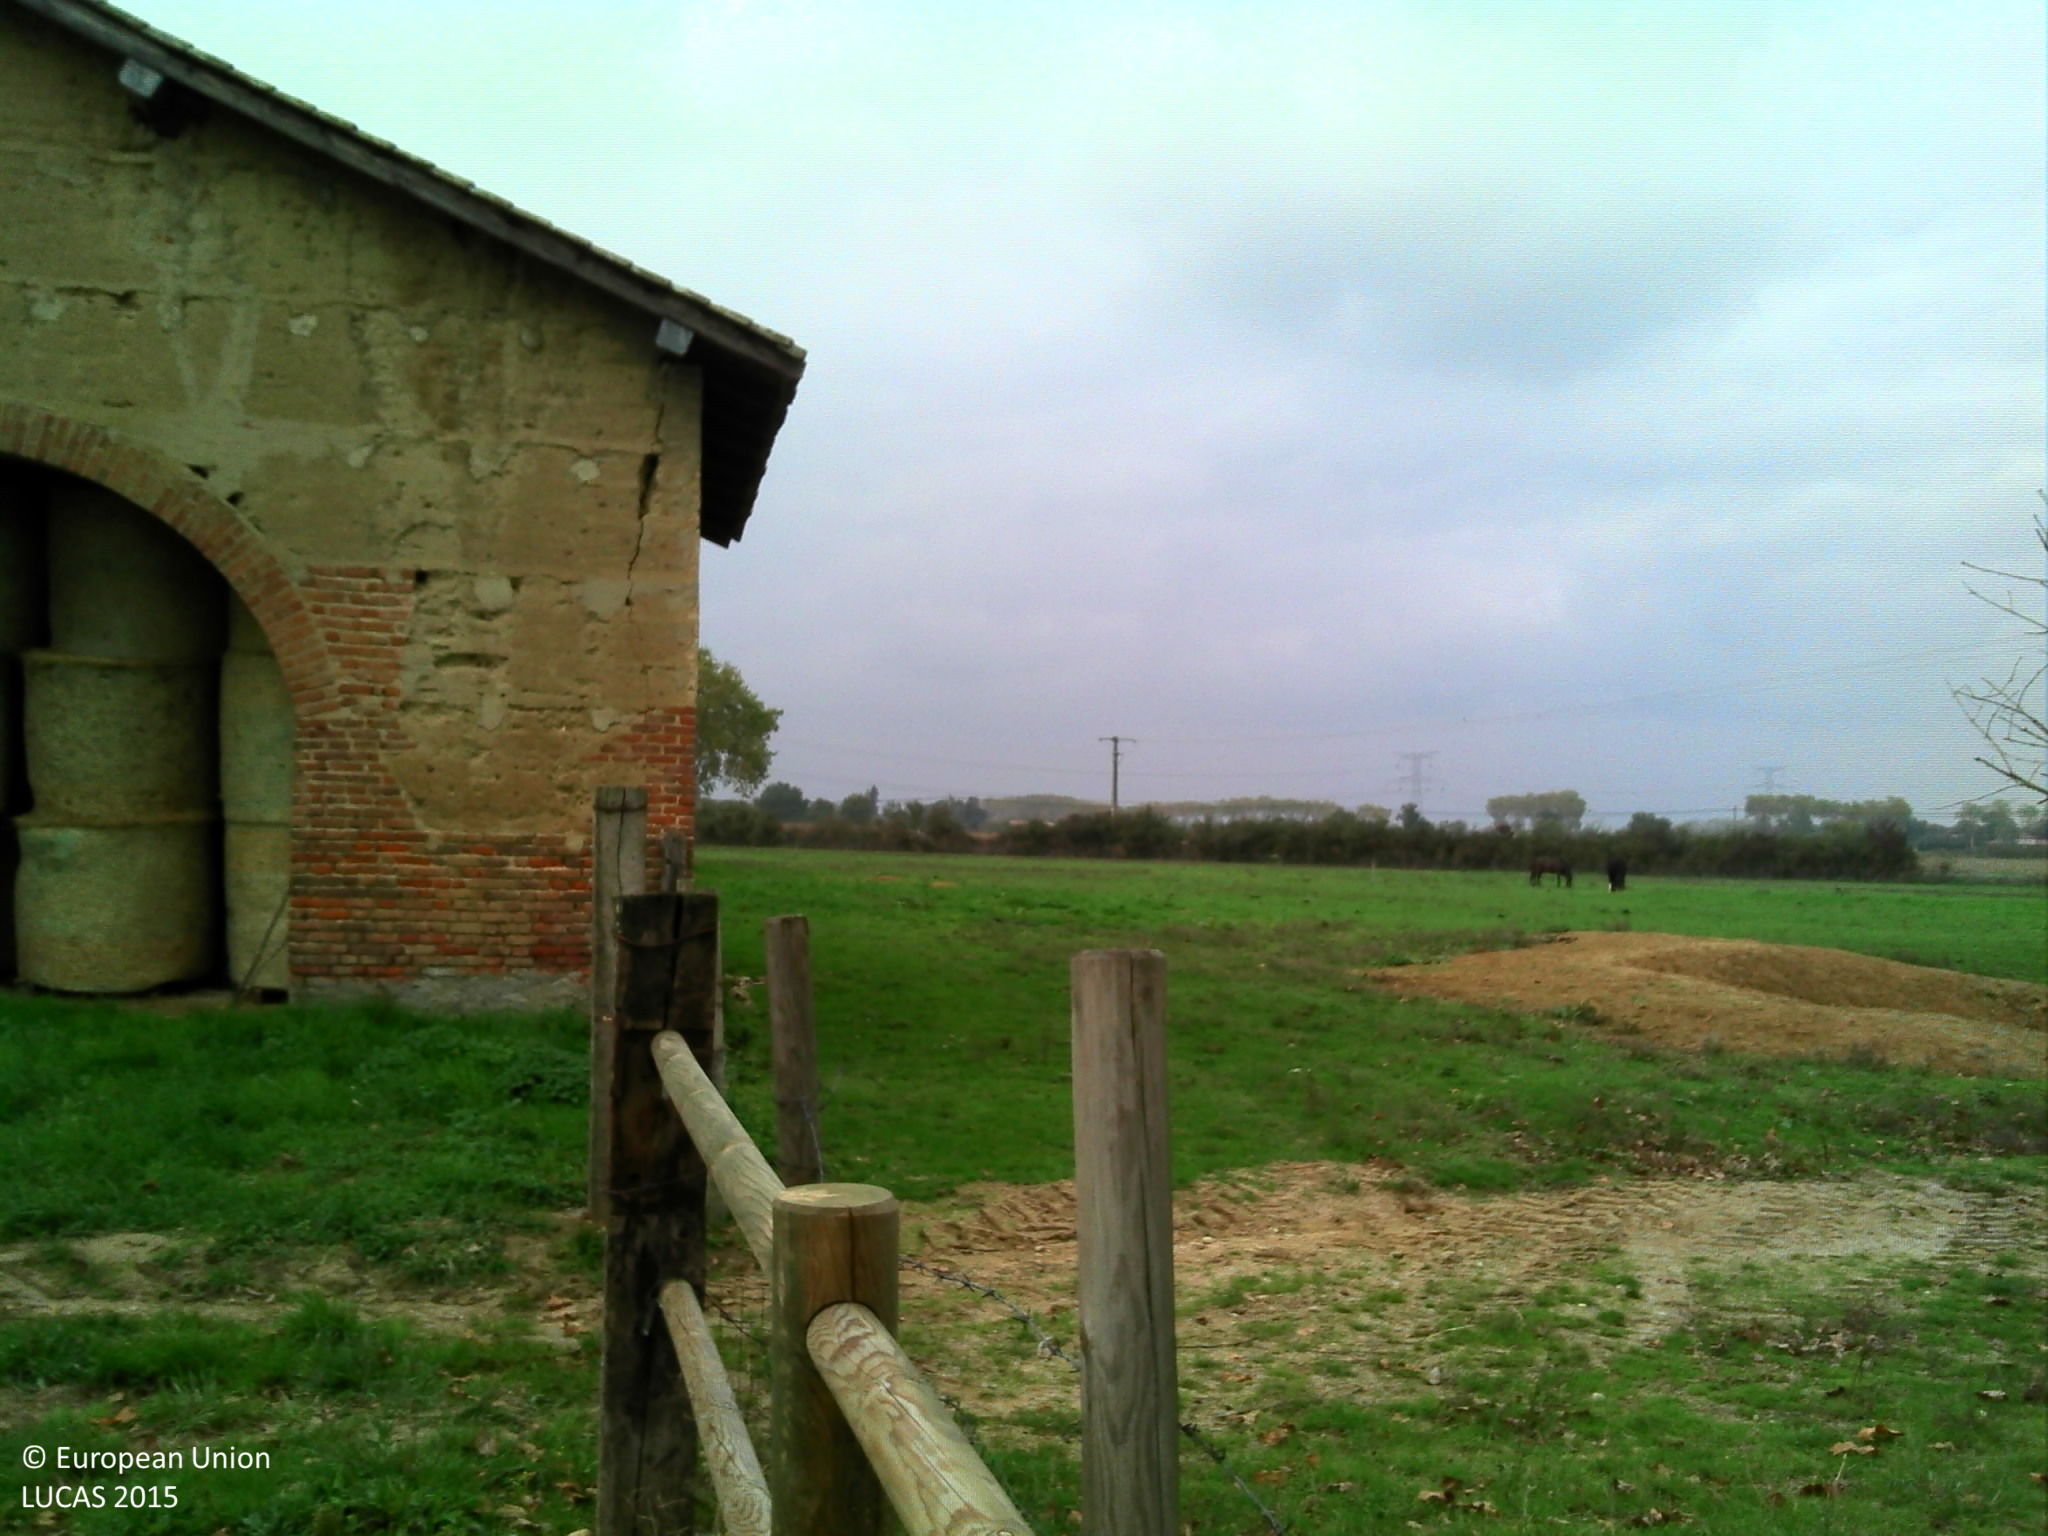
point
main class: Grassland
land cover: Grassland without tree/shrub cover
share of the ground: > 75 %
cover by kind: herbaceous plants 100 %
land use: Agriculture (excluding fallow land and kitchen gardens)
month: October
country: FR
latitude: 46.0670
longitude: 4.8963
